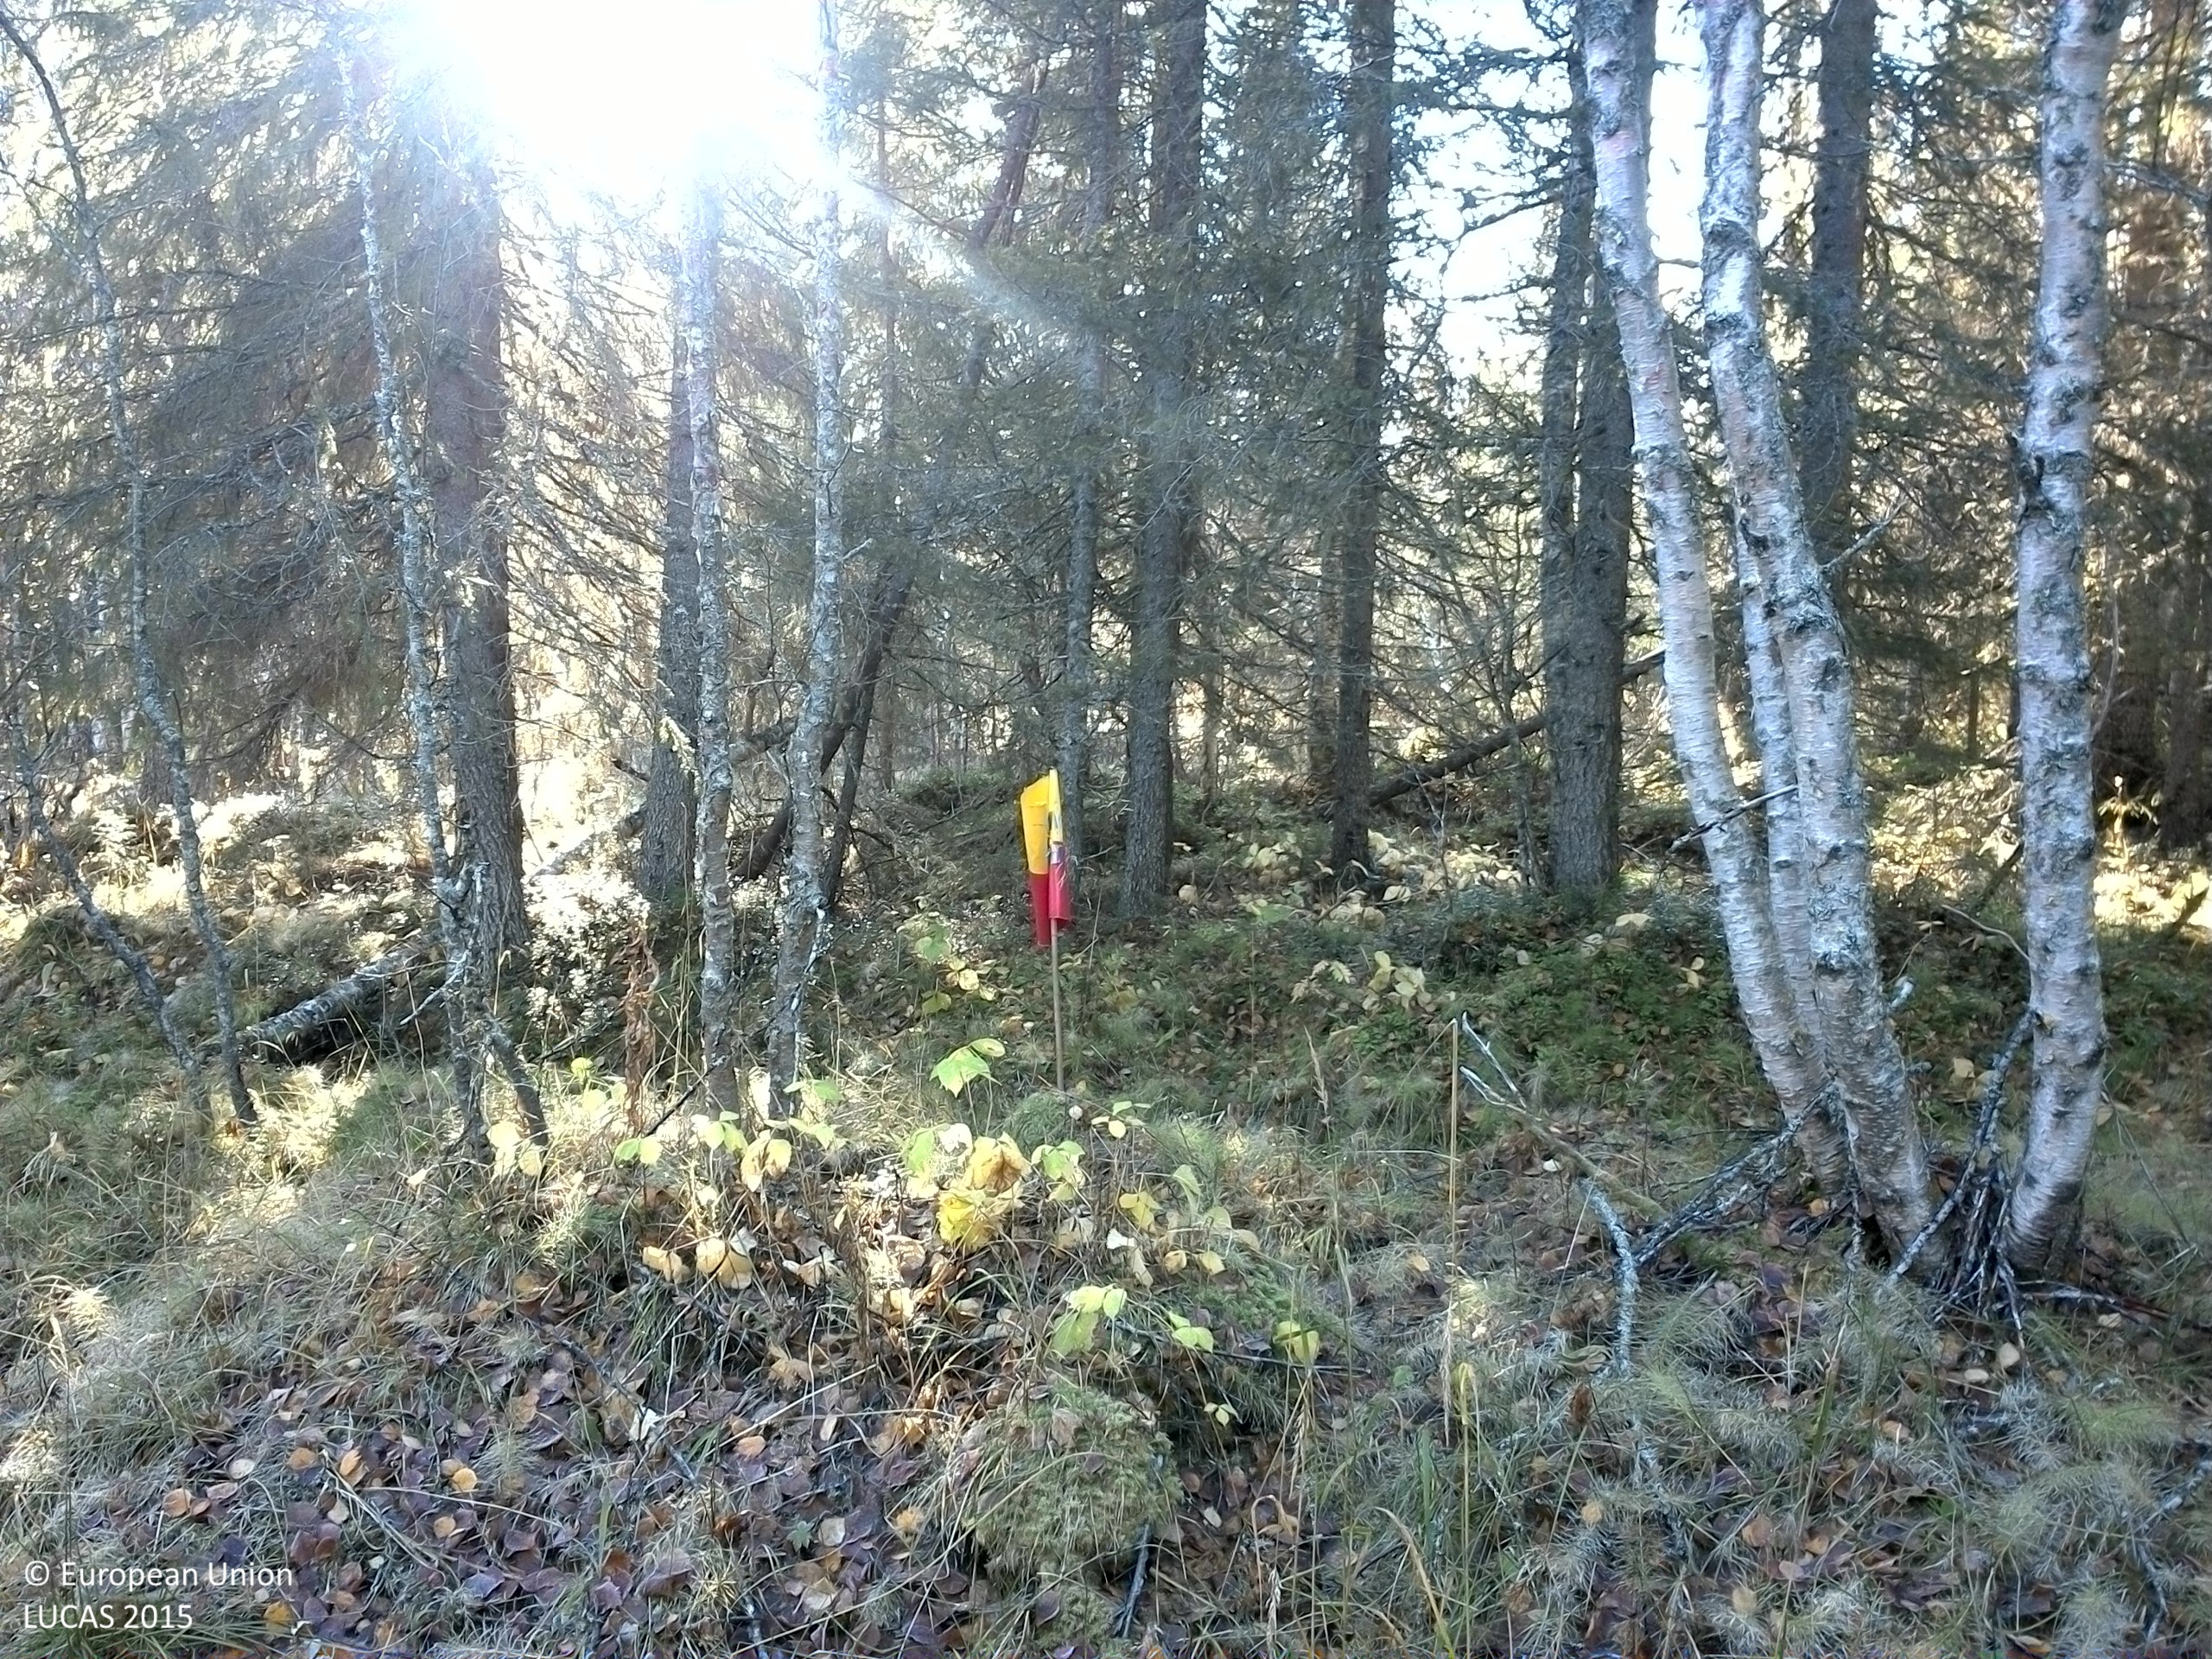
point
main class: Woodland
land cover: Spruce dominated mixed woodland
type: boreal forest
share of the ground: 50 - 75 %
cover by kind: coniferous forest trees 45 %, broadleaved forest trees 20 %, shrubs 15 %, herbaceous plants 10 %, lichens and mosses 10 %
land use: Forestry
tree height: > 5 m
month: October
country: SE
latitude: 64.4830
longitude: 15.5252
